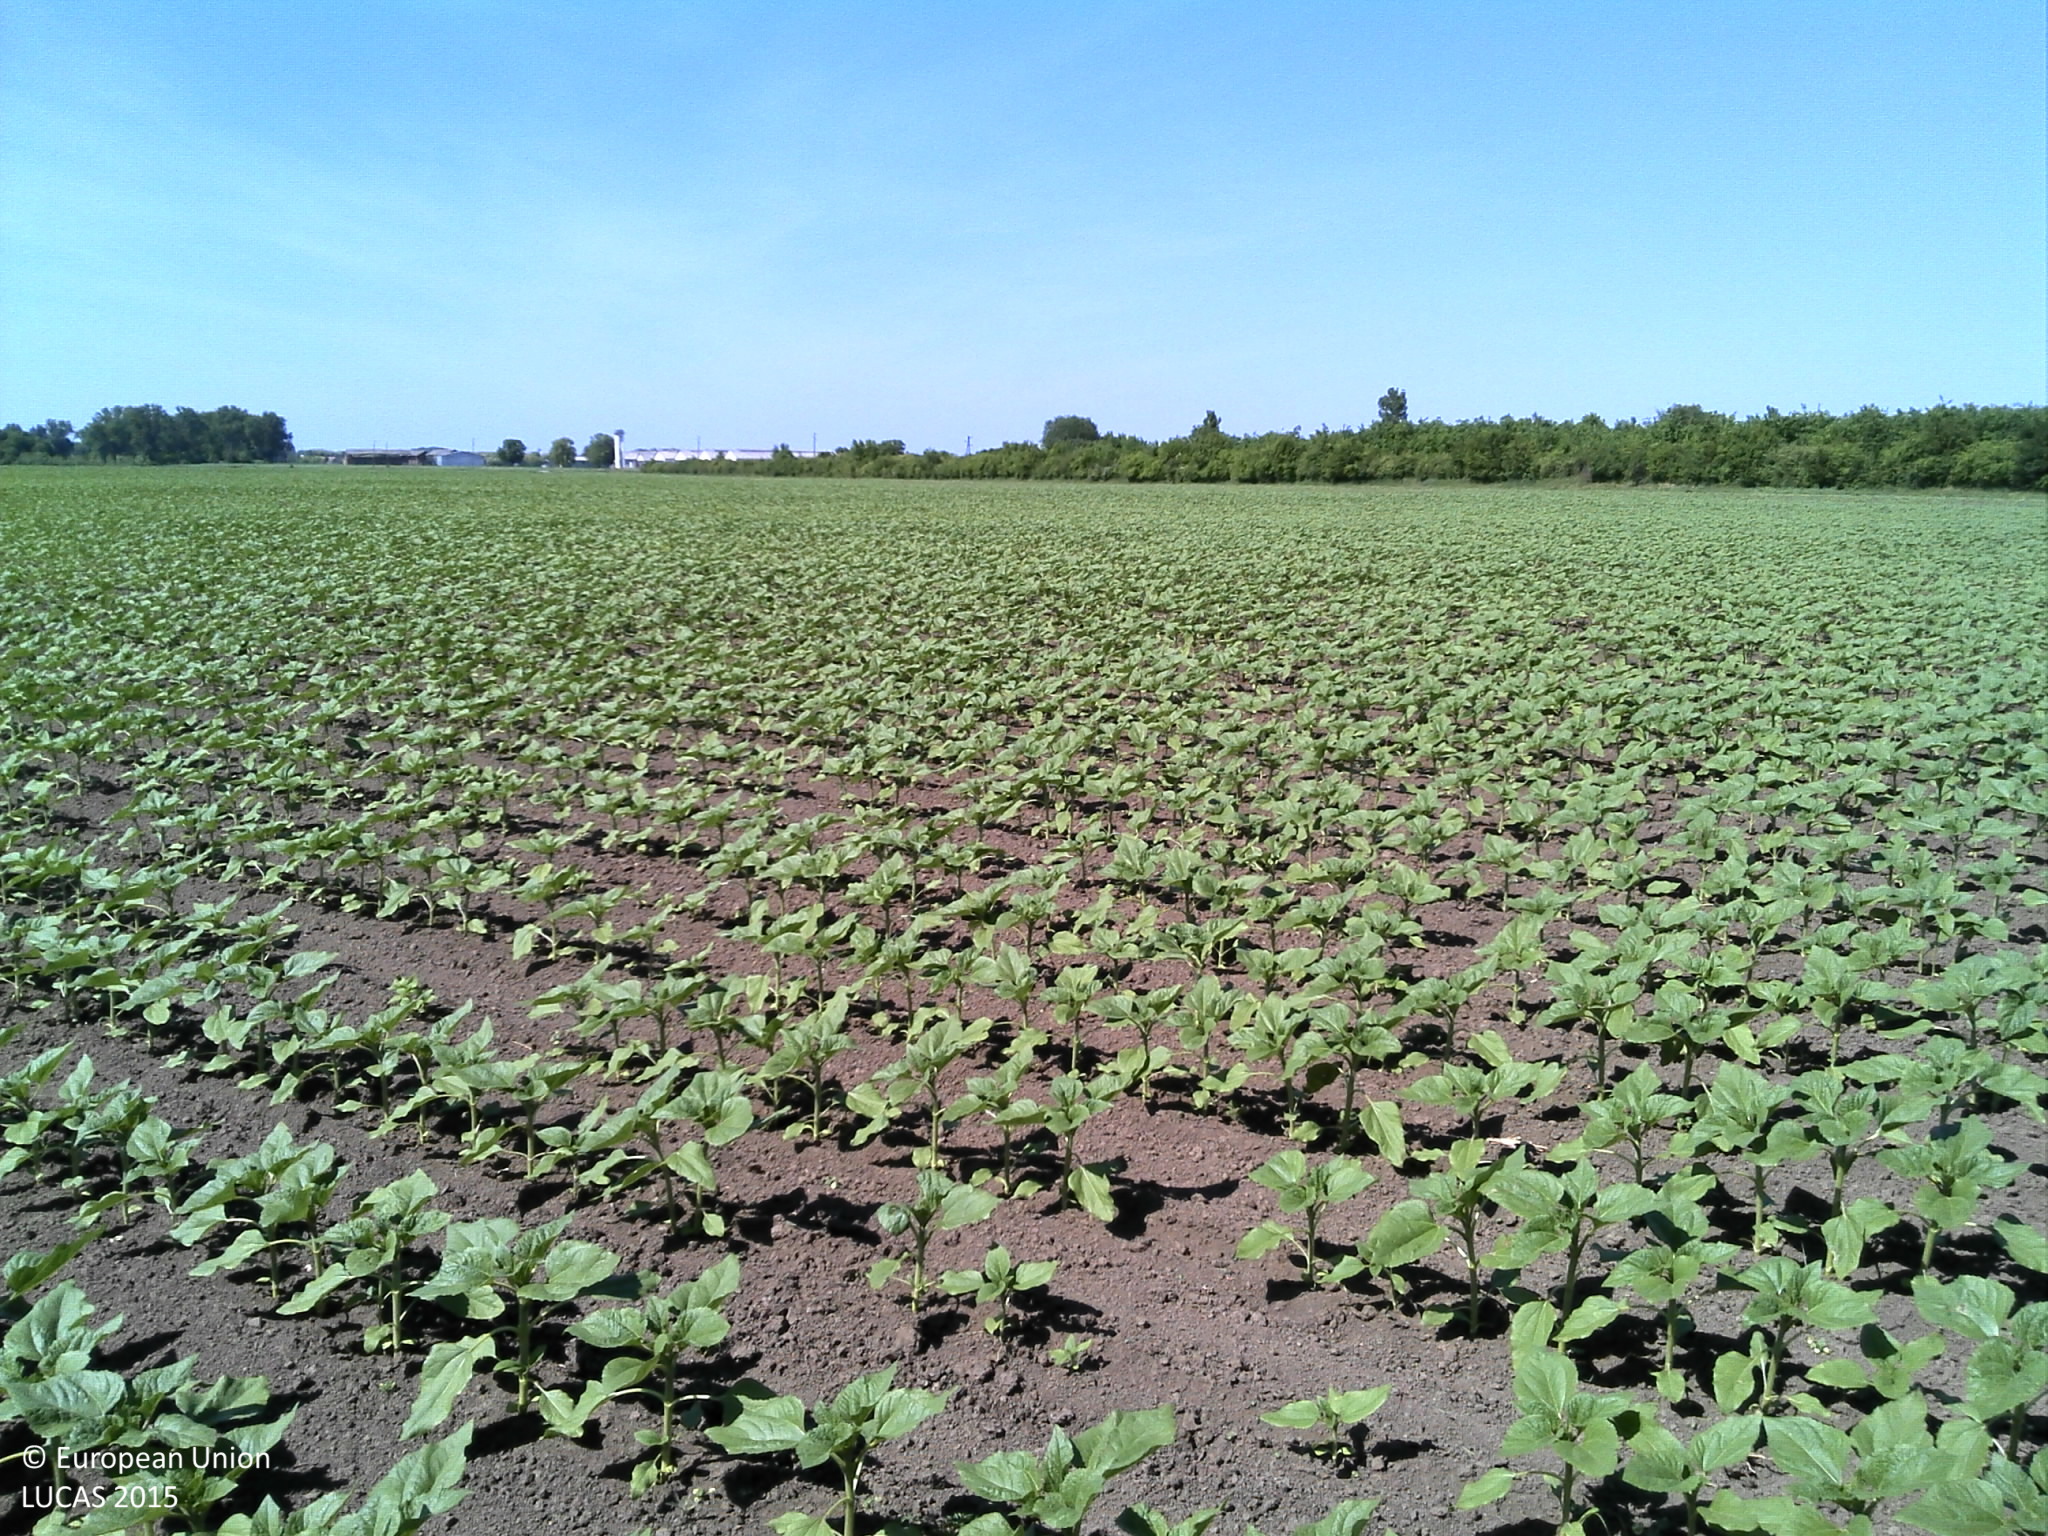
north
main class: Cropland
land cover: Sunflower
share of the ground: 10 - 25 %
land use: Agriculture (excluding fallow land and kitchen gardens)
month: May
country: HR
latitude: 45.8217
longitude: 18.6192
